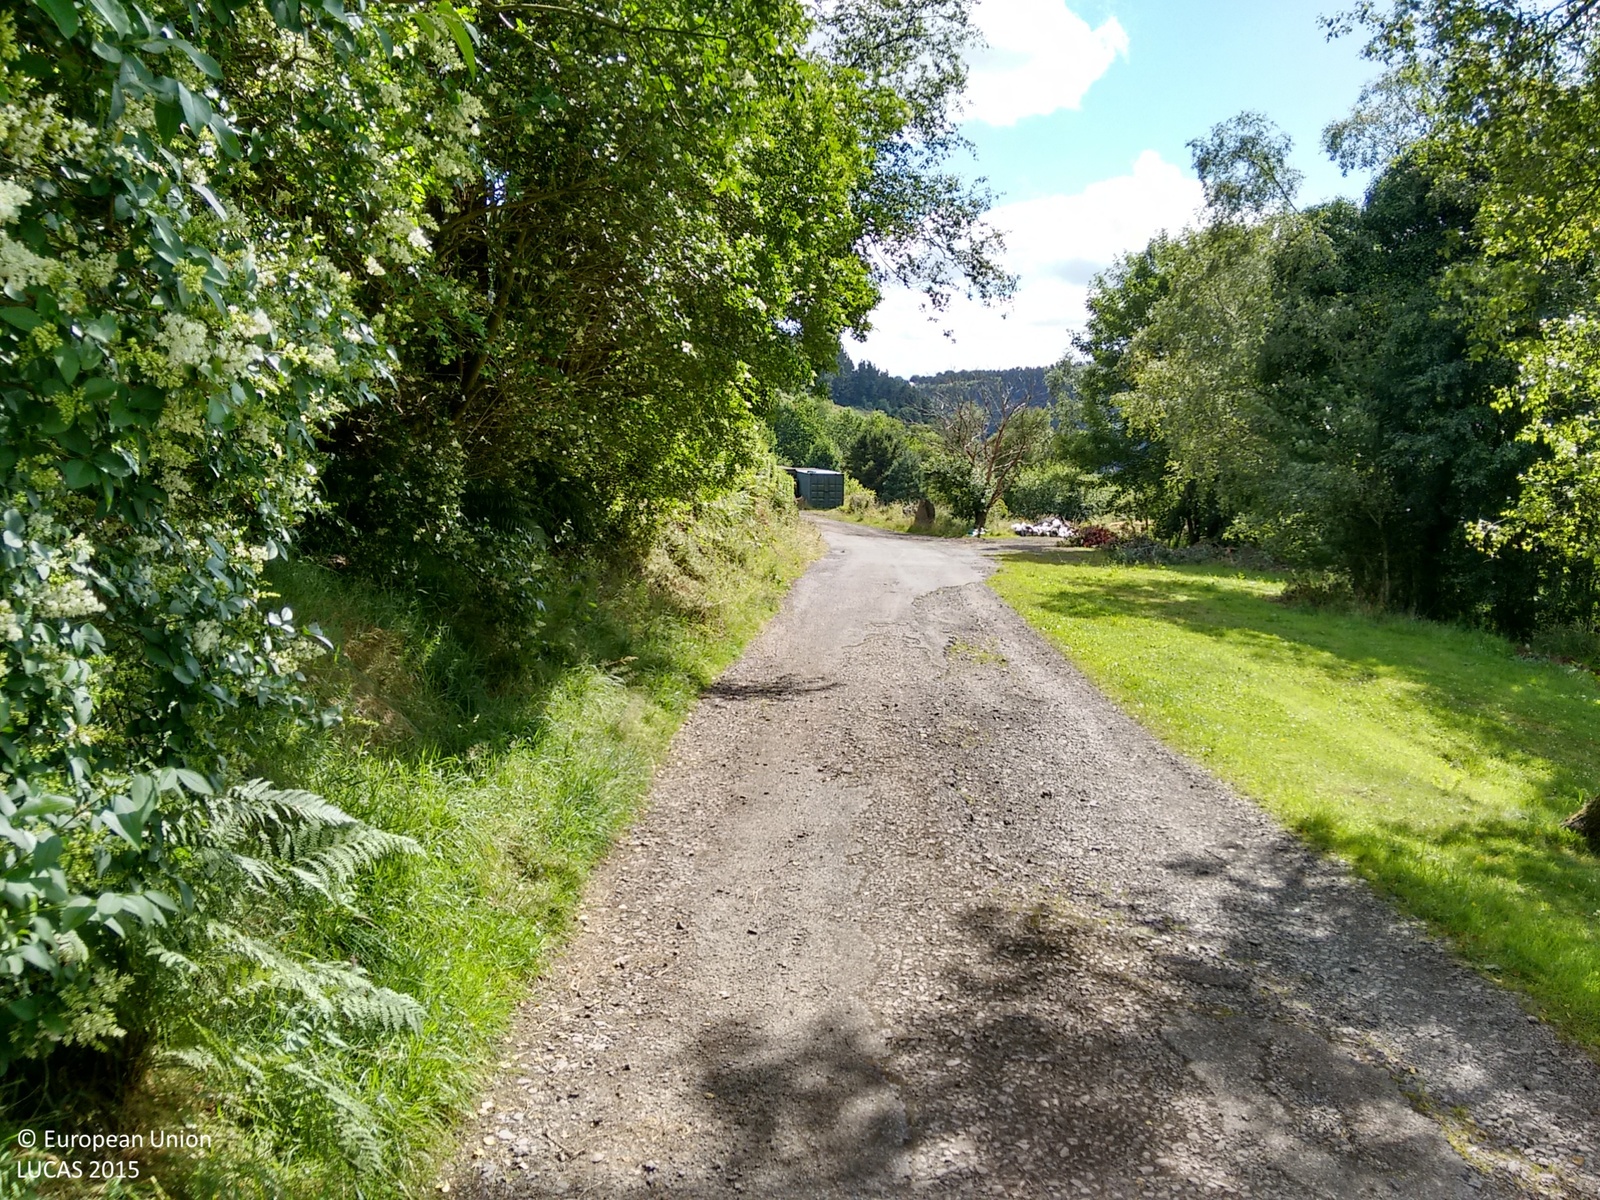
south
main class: Grassland
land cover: Grassland without tree/shrub cover
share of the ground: > 75 %
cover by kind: herbaceous plants 100 %
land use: Residential
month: July
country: GB
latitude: 51.7358
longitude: -3.1244
